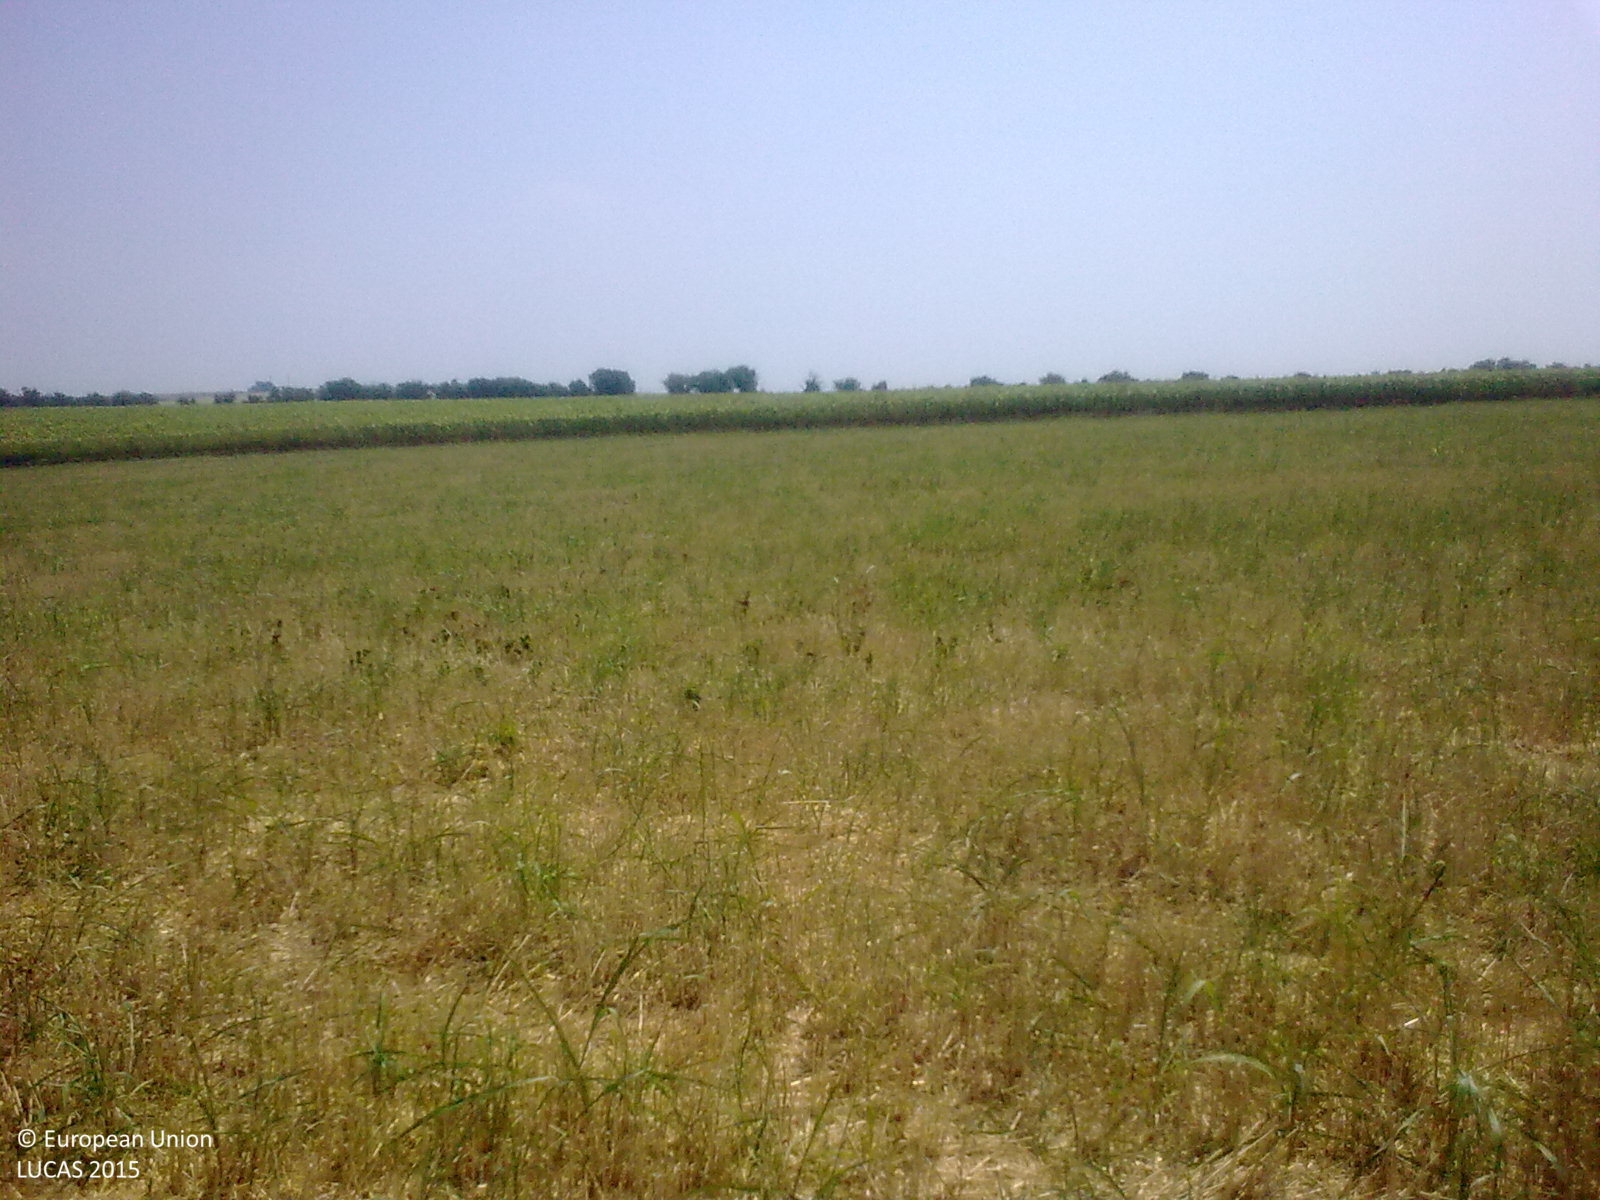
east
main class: Cropland
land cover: Common wheat
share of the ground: 50 - 75 %
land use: Agriculture (excluding fallow land and kitchen gardens)
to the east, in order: Common wheat; Other bare soil; Grass margins; Sunflower
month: July
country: BG
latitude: 43.6025
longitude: 25.8358
